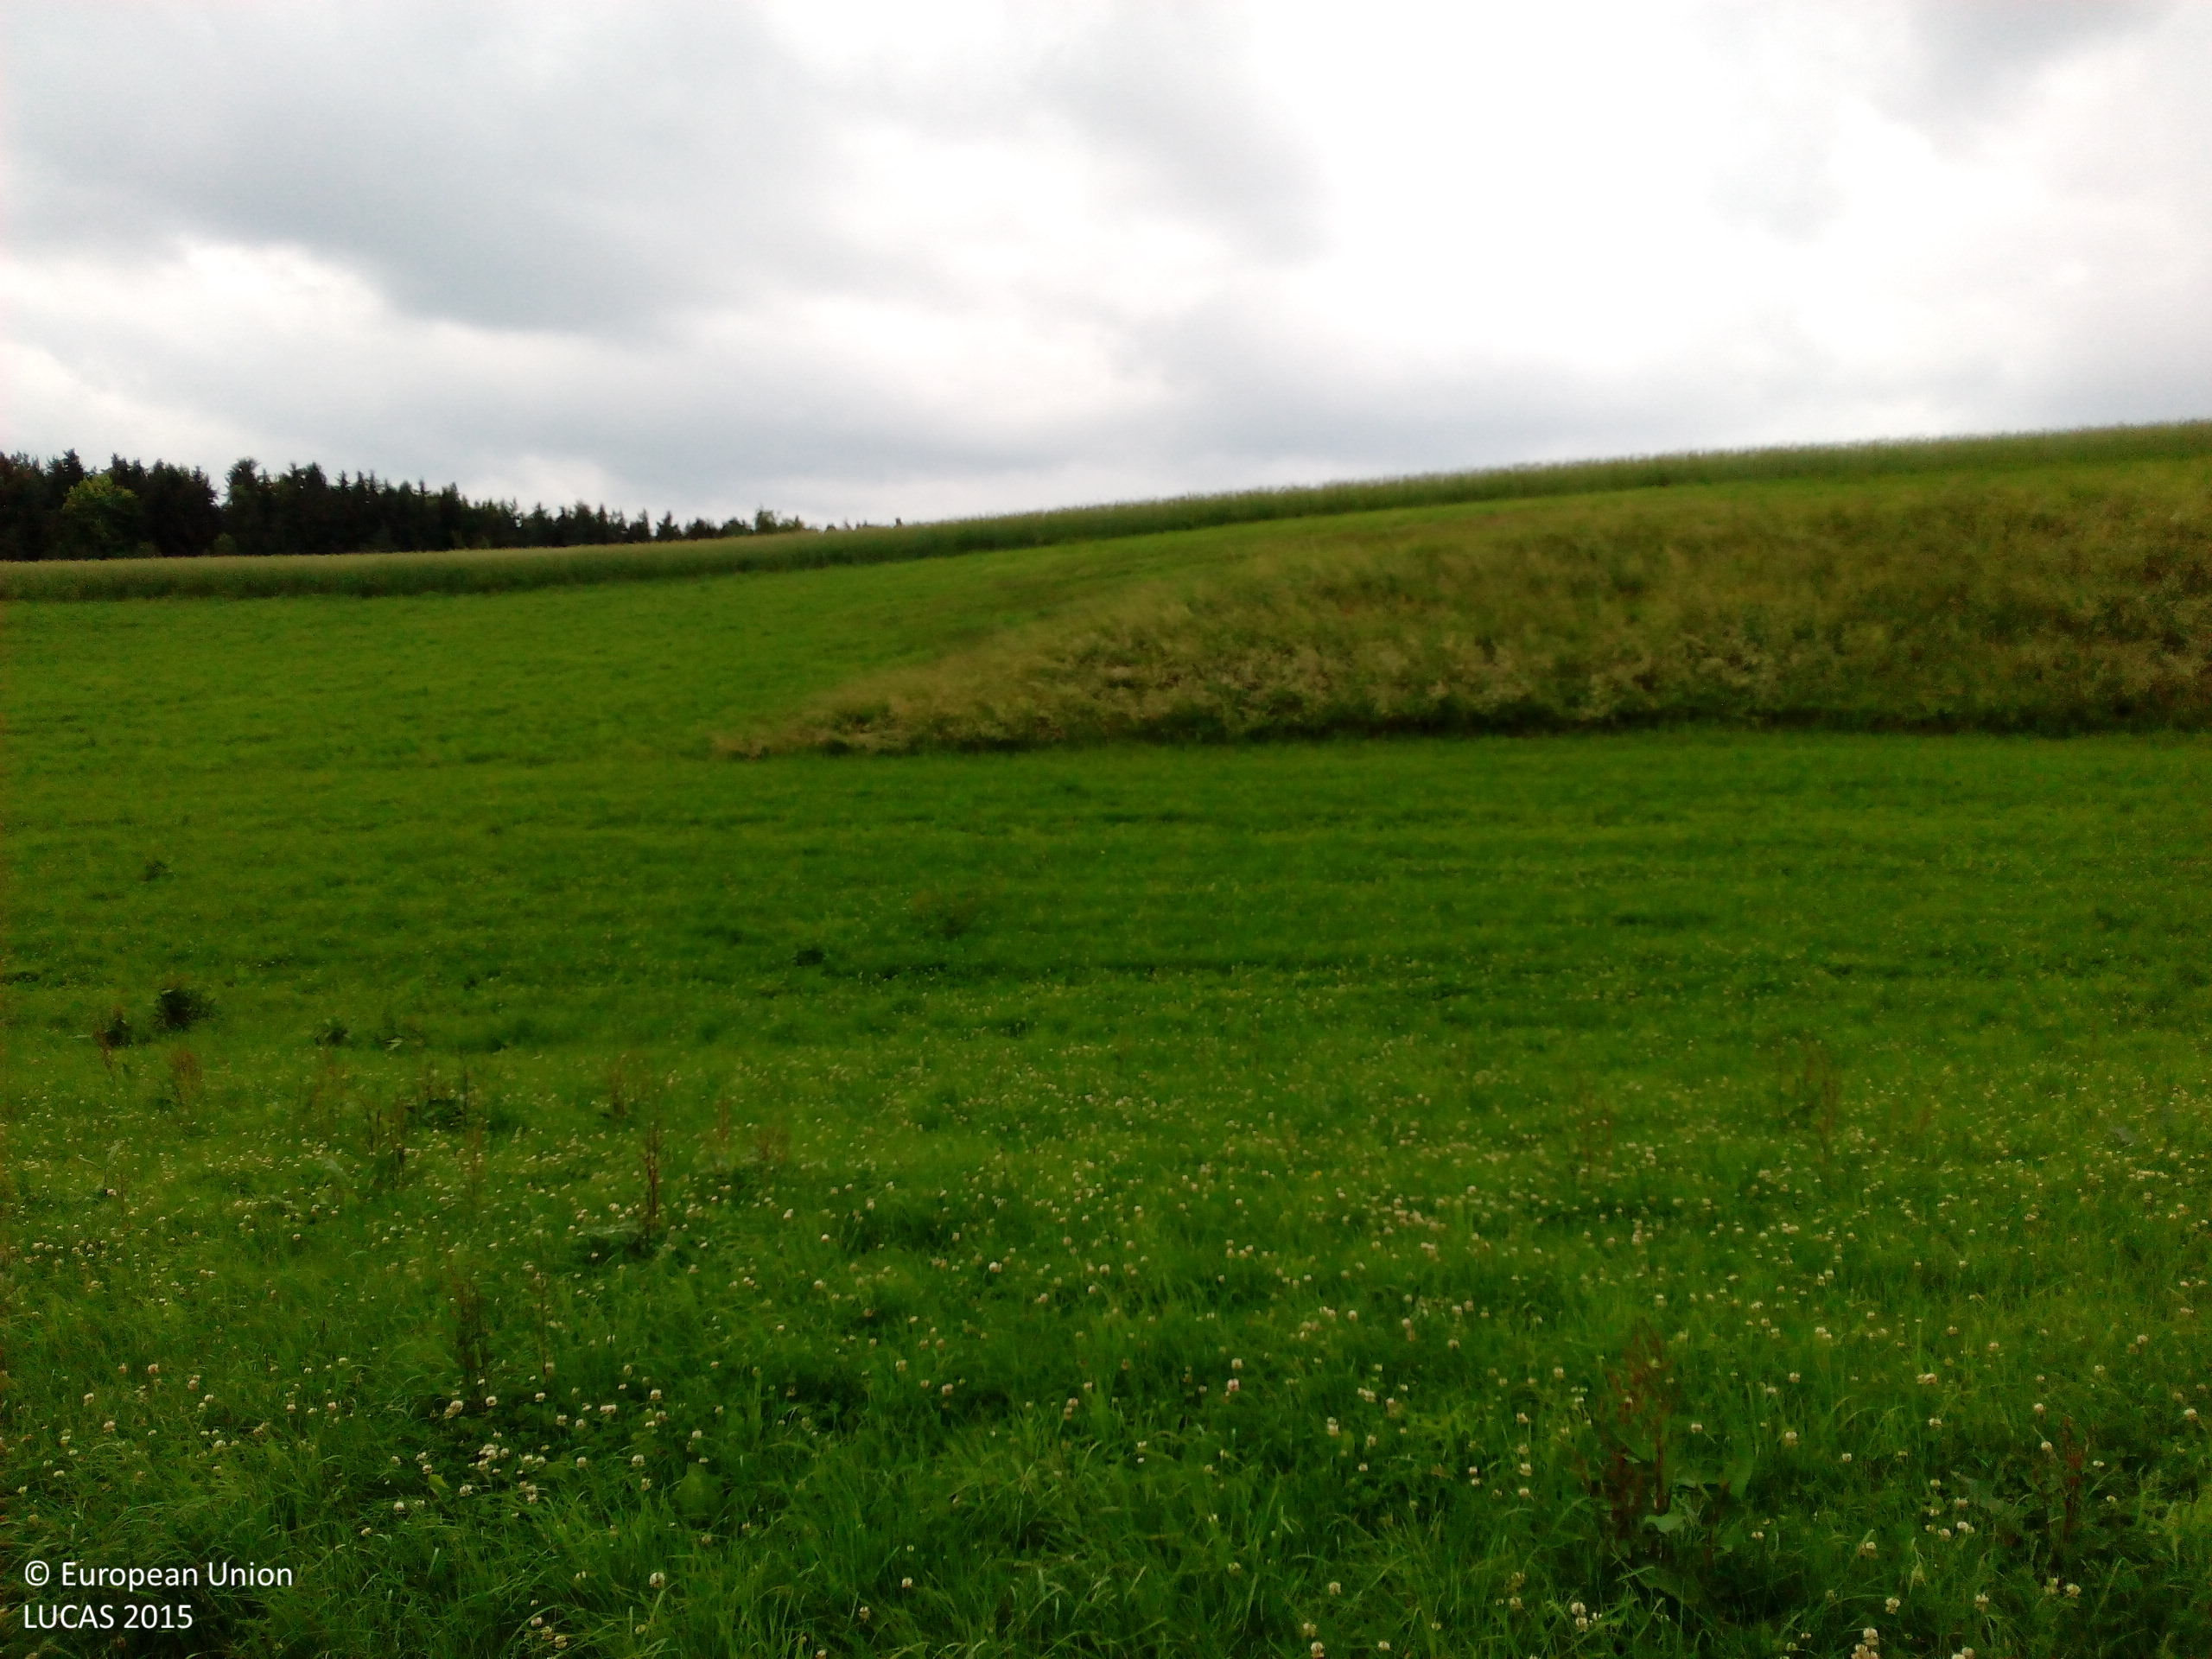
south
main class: Grassland
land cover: Grassland without tree/shrub cover
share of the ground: > 75 %
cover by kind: herbaceous plants 100 %
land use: Agriculture (excluding fallow land and kitchen gardens)
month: June
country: DE
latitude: 49.1149
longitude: 12.4244
